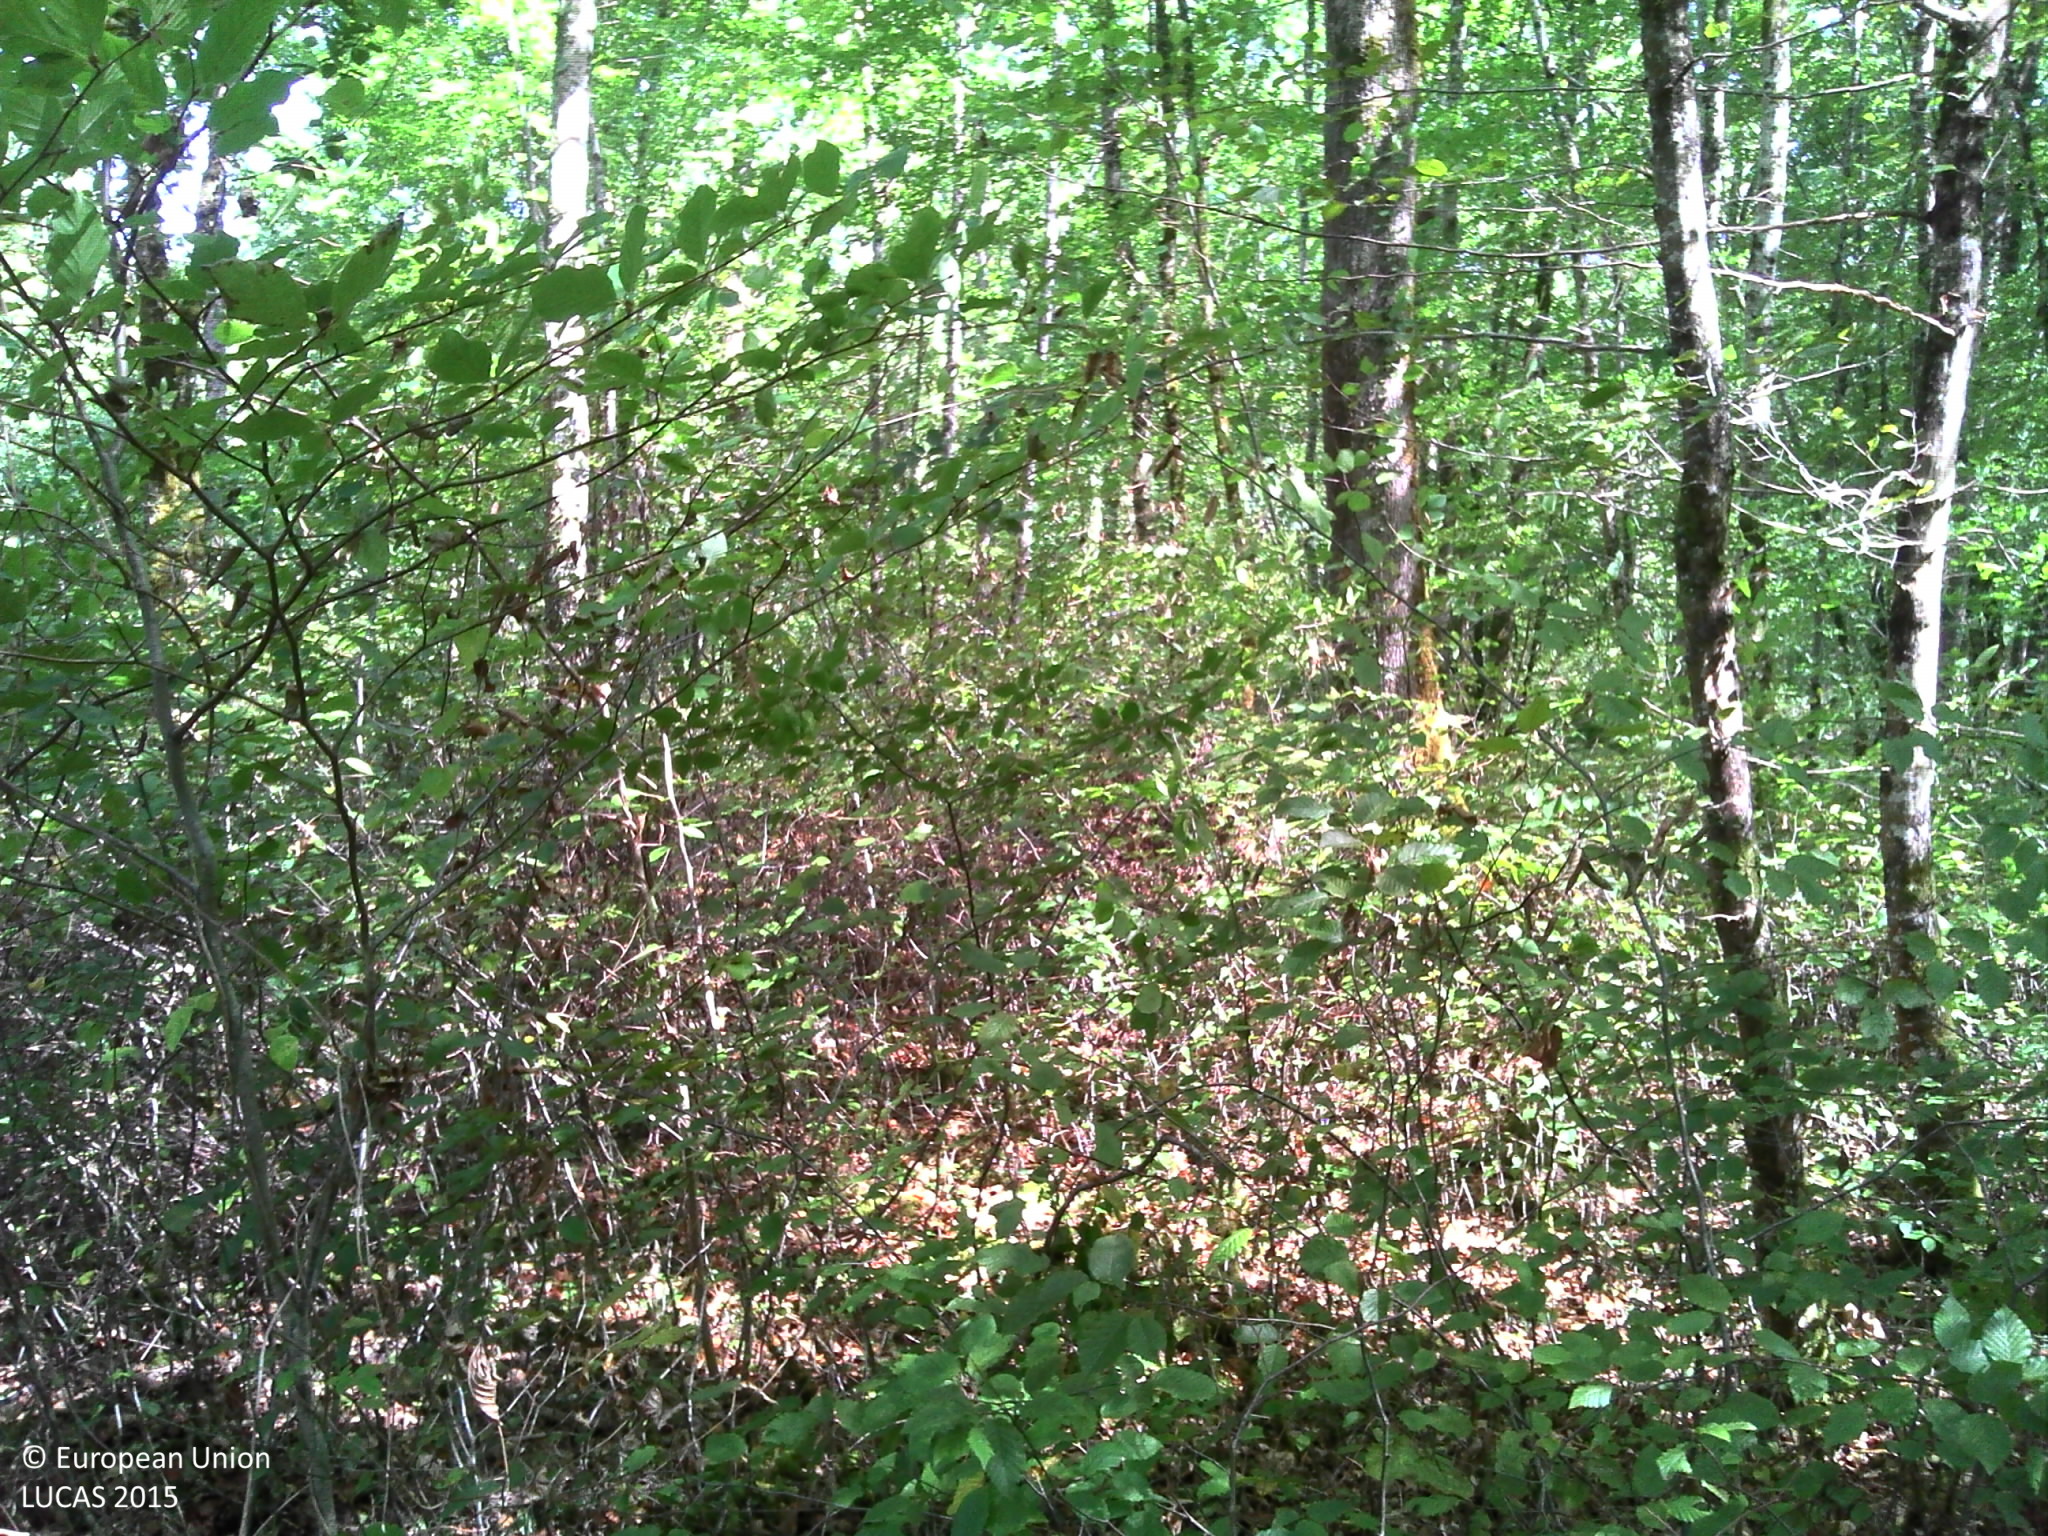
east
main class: Woodland
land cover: Broadleaved woodland
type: mesophytic deciduous forest
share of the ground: > 75 %
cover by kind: broadleaved forest trees 90 %, herbaceous plants 5 %, lichens and mosses 5 %
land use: Forestry
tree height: > 5 m
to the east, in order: Broadleaved woodland; Tracks; Broadleaved woodland
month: August
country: FR
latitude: 47.8228
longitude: 4.6426
